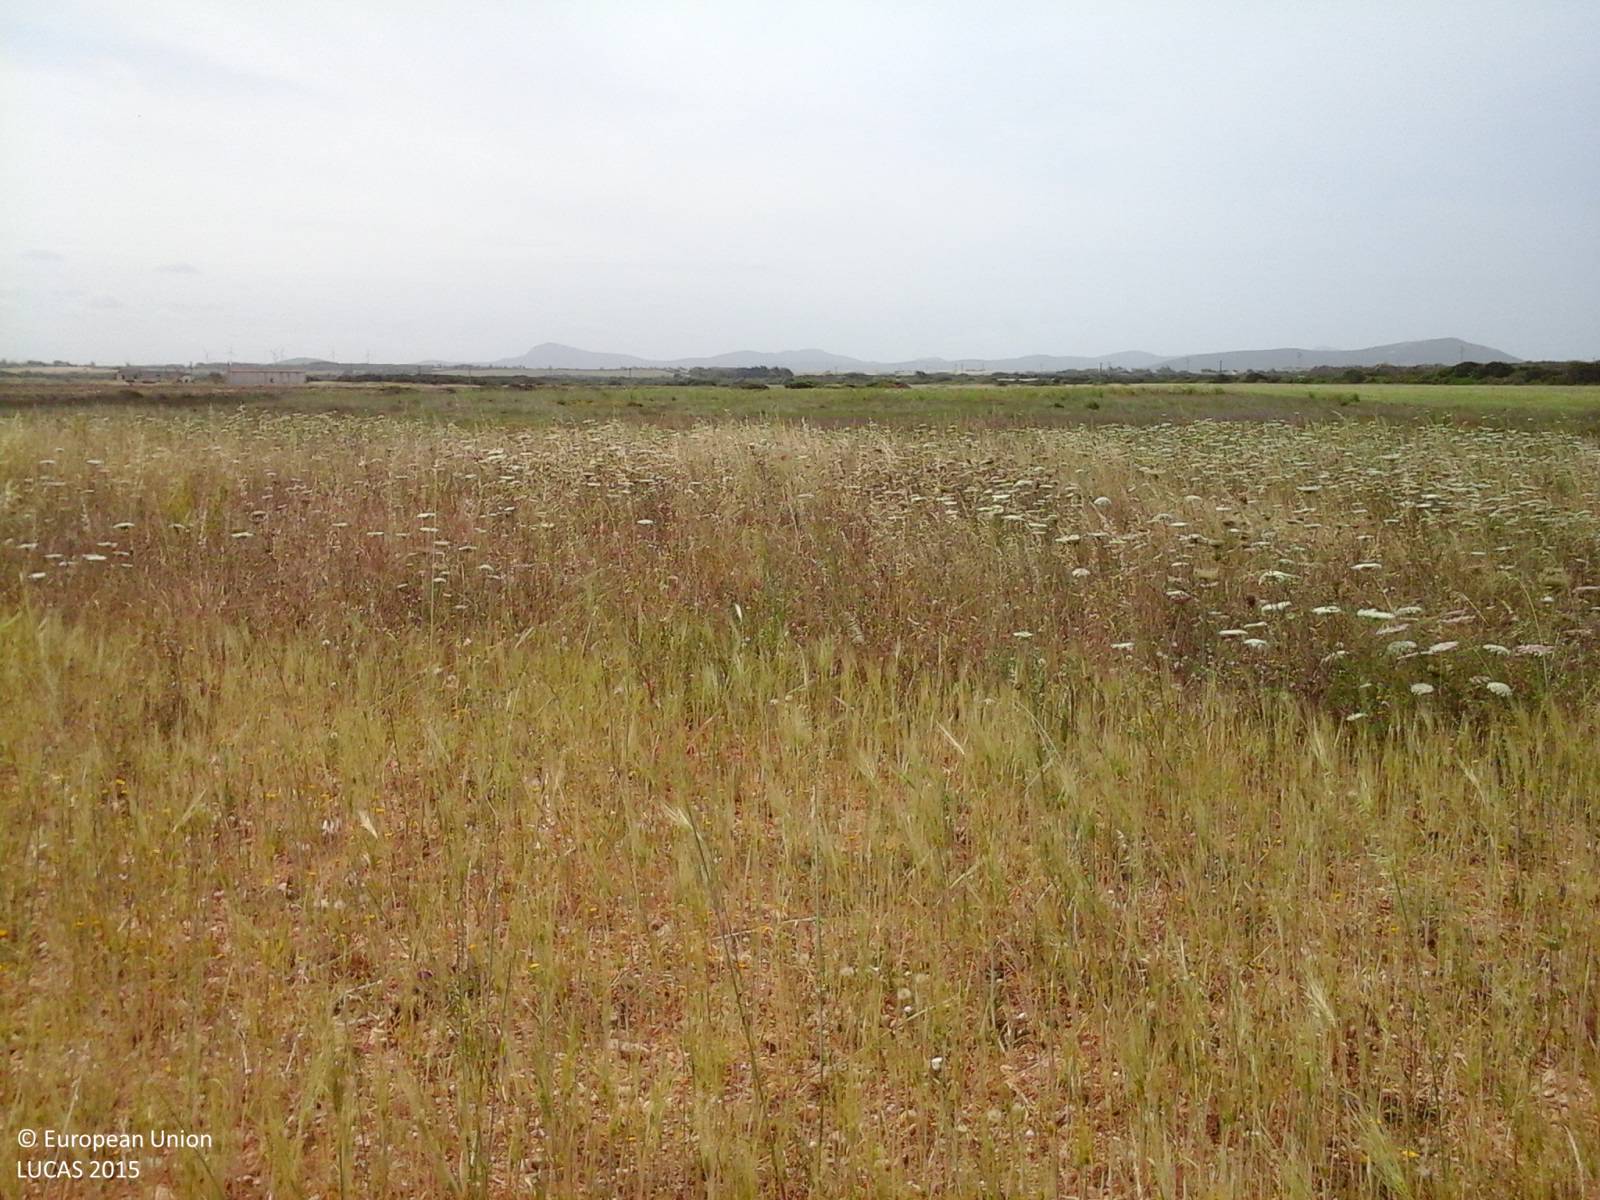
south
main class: Cropland
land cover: Durum wheat
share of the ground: > 75 %
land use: Agriculture (excluding fallow land and kitchen gardens)
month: May
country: IT
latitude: 40.8851
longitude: 8.2399
